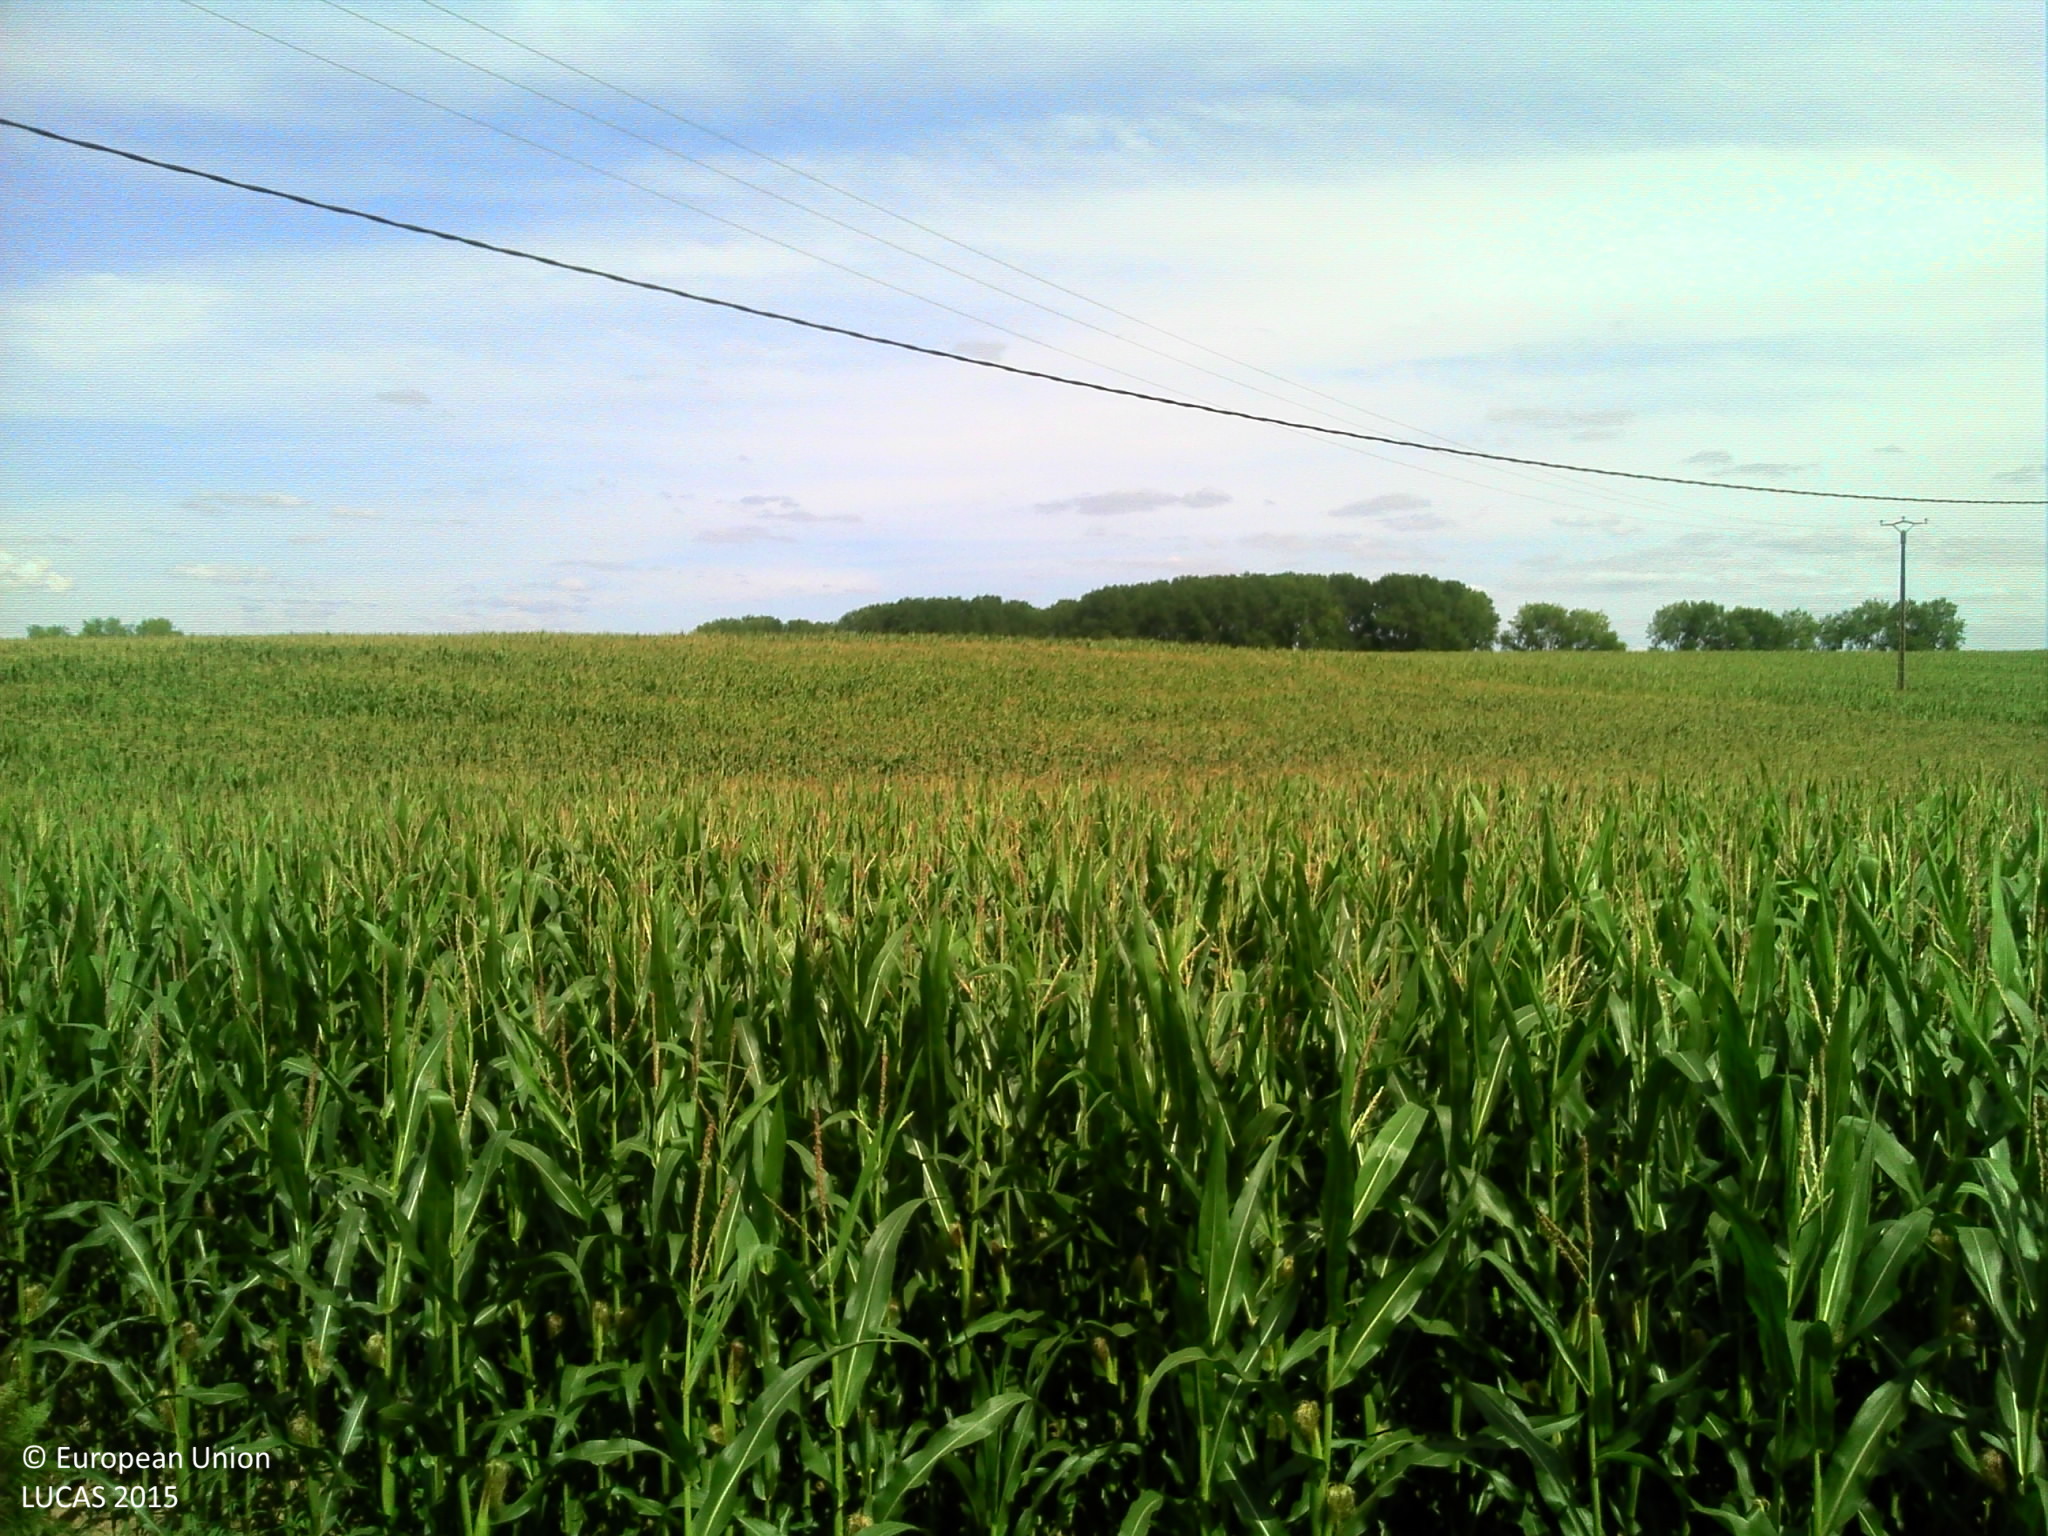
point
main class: Cropland
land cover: Maize
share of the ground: > 75 %
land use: Agriculture (excluding fallow land and kitchen gardens)
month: July
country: FR
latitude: 47.9996
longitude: -2.9739
